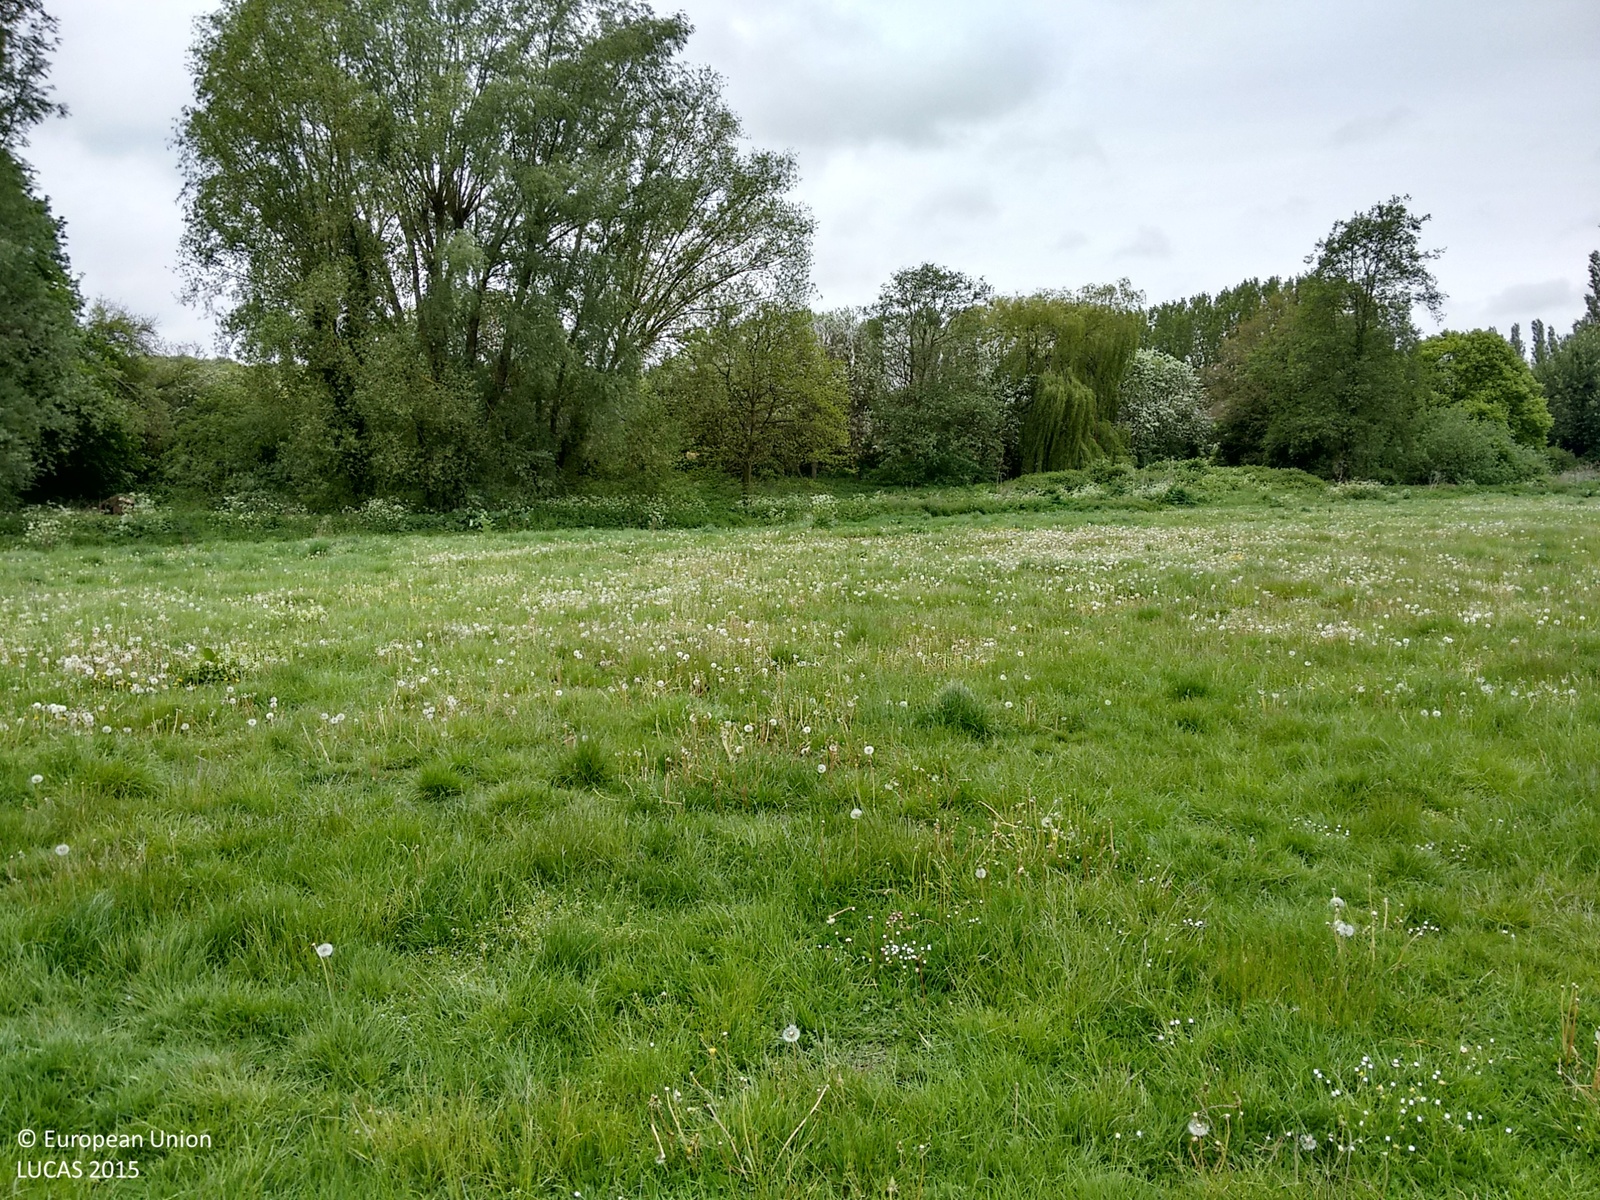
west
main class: Grassland
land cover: Grassland without tree/shrub cover
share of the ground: > 75 %
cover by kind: herbaceous plants 100 %
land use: Amenities, museums, leisure
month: May
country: GB
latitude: 51.7160
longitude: -0.4447
